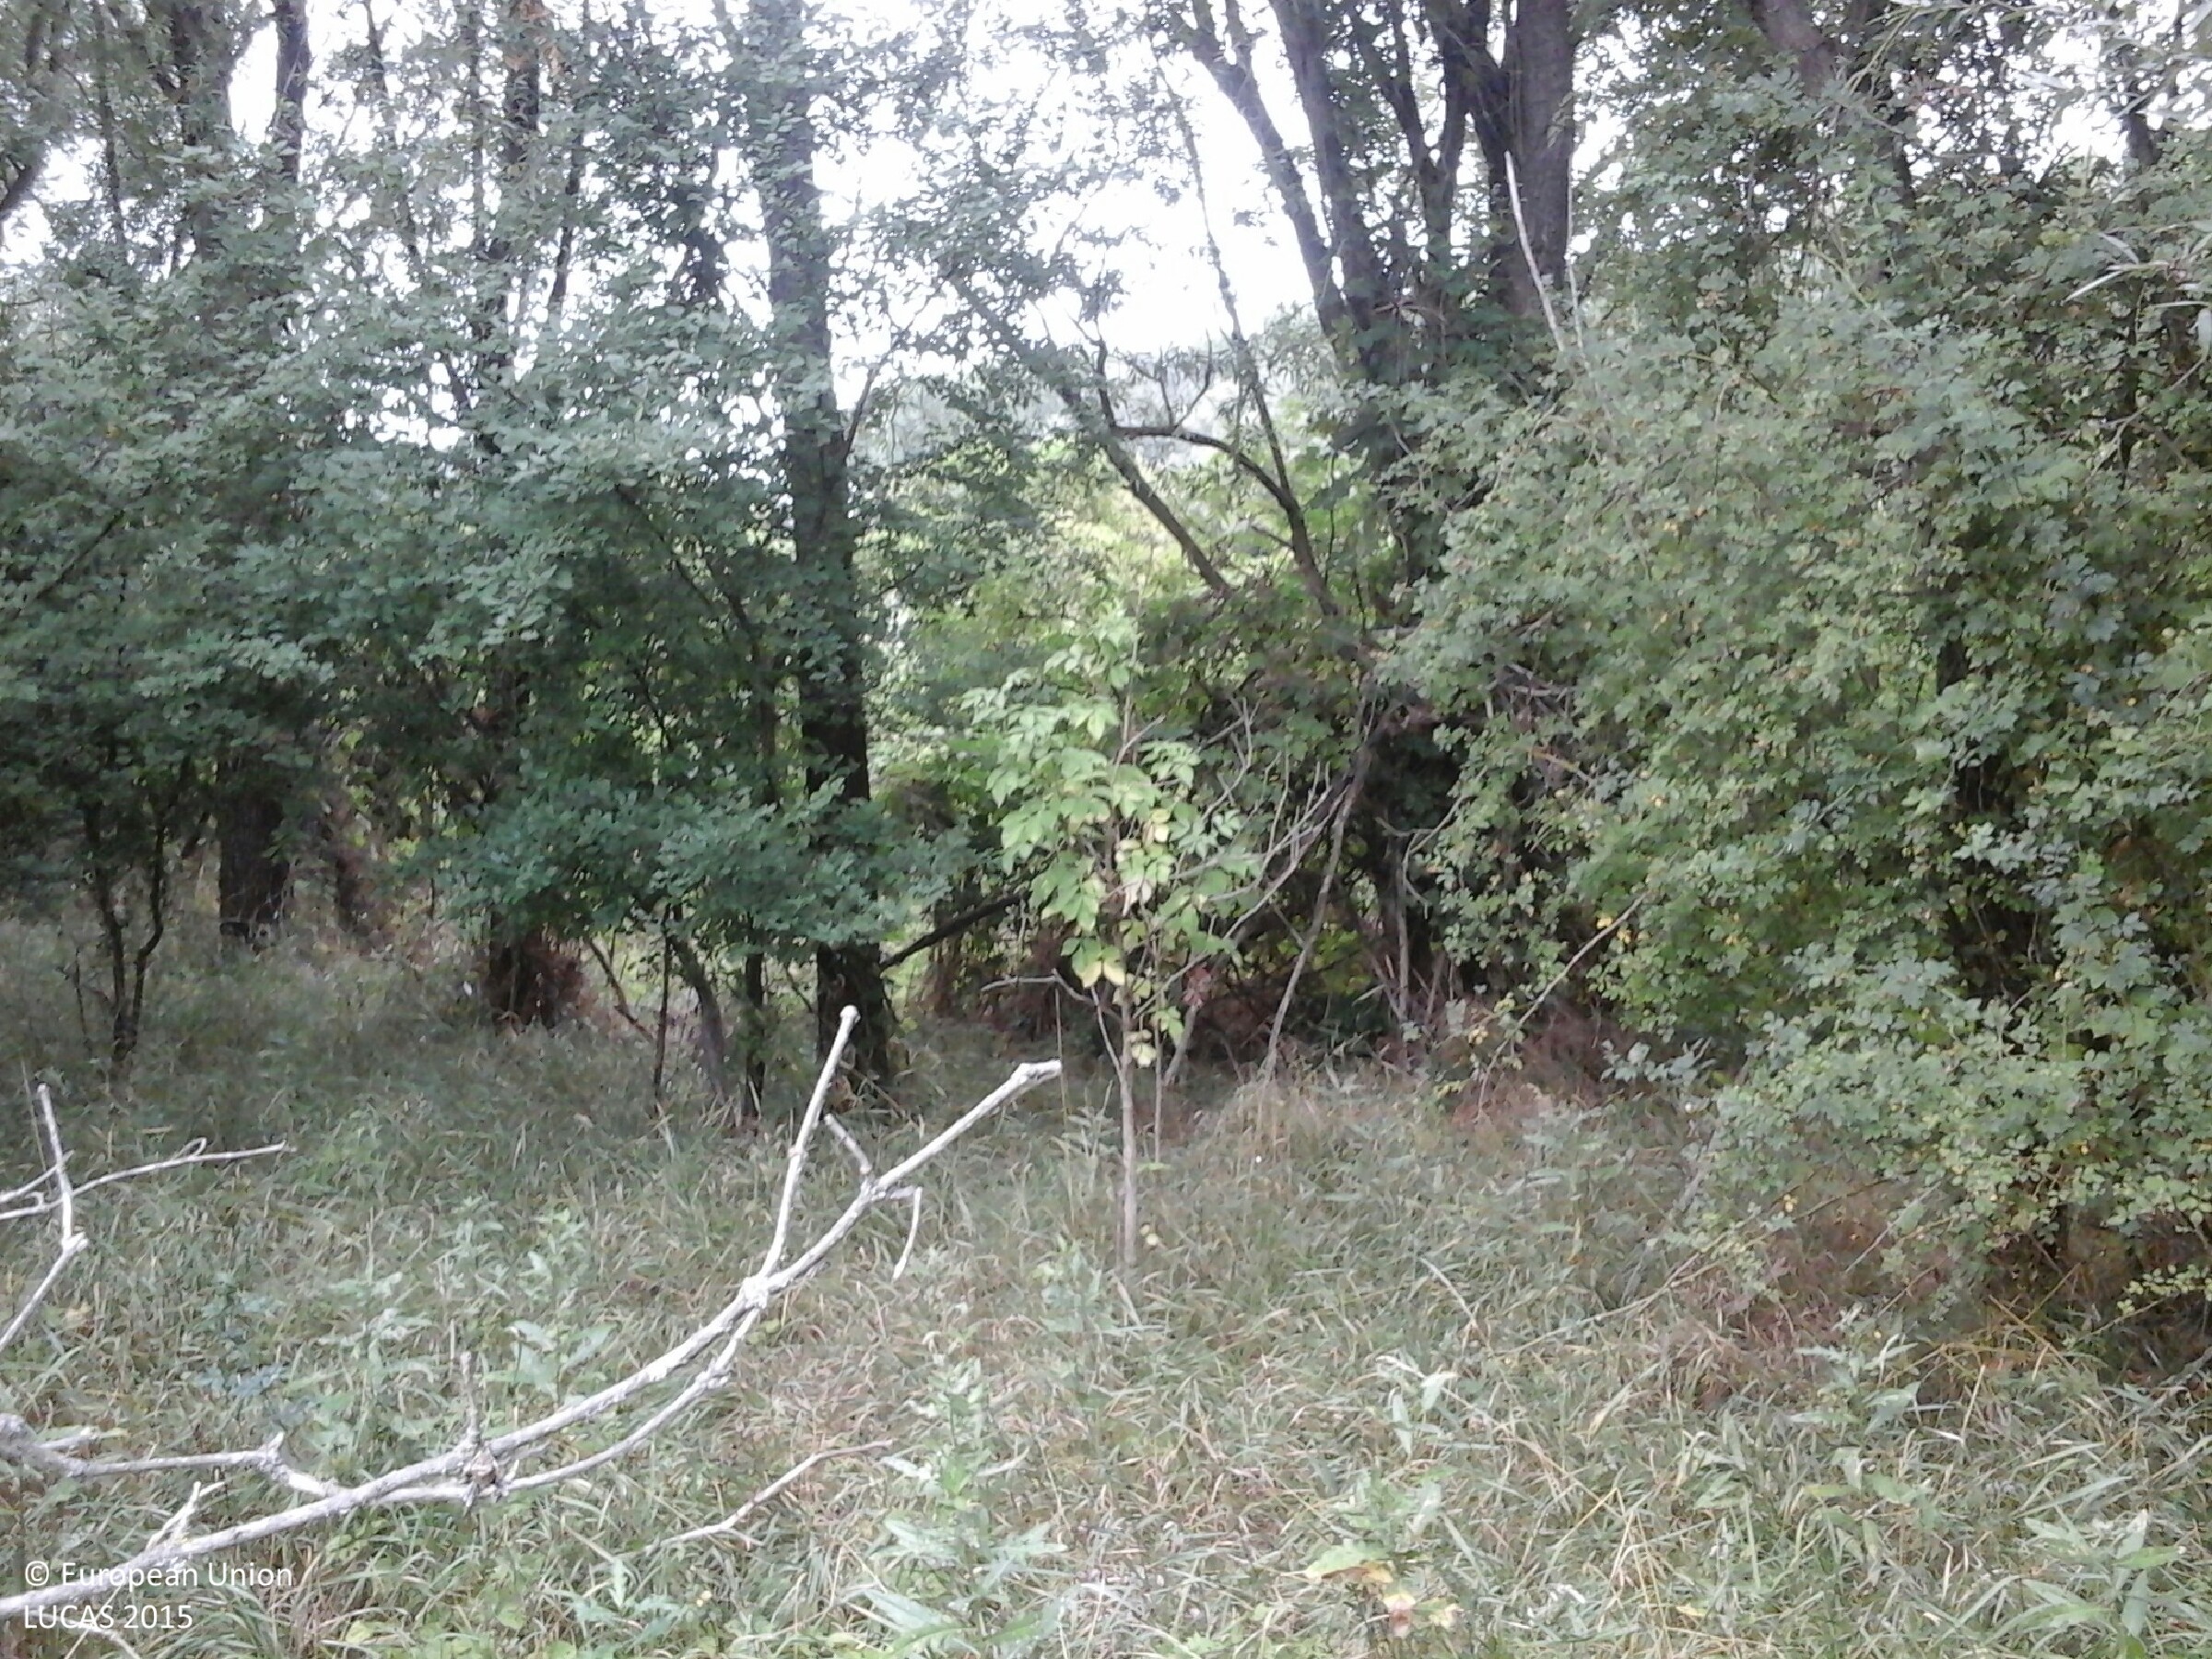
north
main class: Woodland
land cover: Broadleaved woodland
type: mesophytic deciduous forest
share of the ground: 50 - 75 %
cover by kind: broadleaved forest trees 70 %, herbaceous plants 30 %
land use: Forestry
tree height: > 5 m
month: July
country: HU
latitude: 47.5277
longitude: 20.6183
